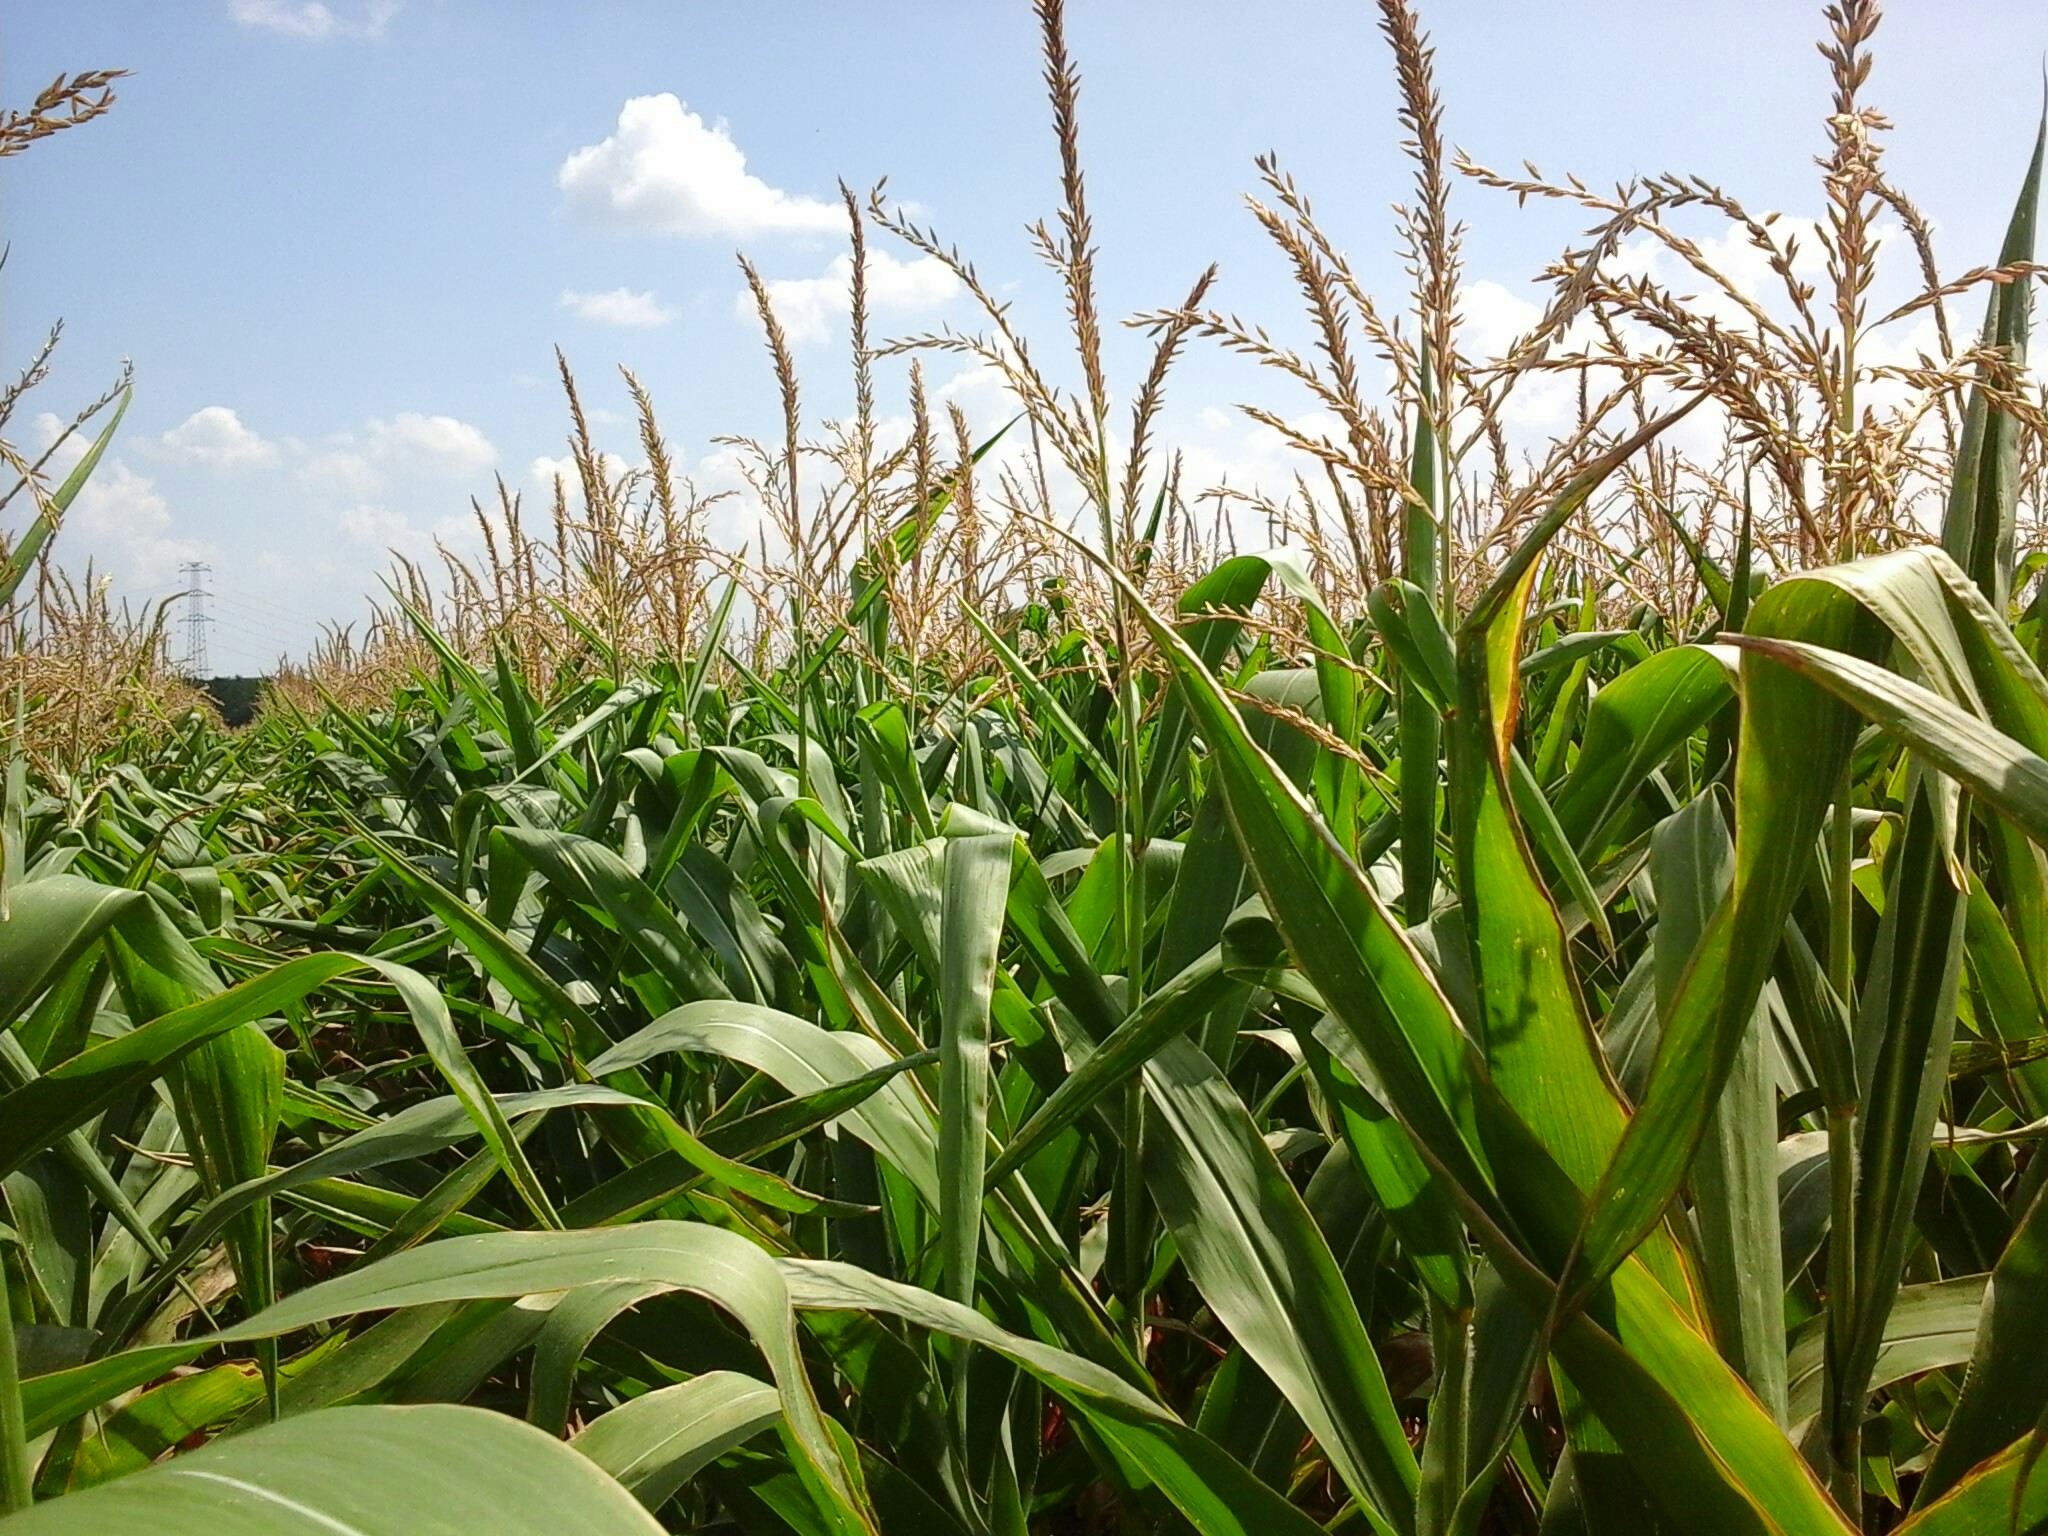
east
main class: Cropland
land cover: Maize
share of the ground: > 75 %
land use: Agriculture (excluding fallow land and kitchen gardens)
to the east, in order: Maize
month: August
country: HU
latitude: 47.5689
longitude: 18.0265
